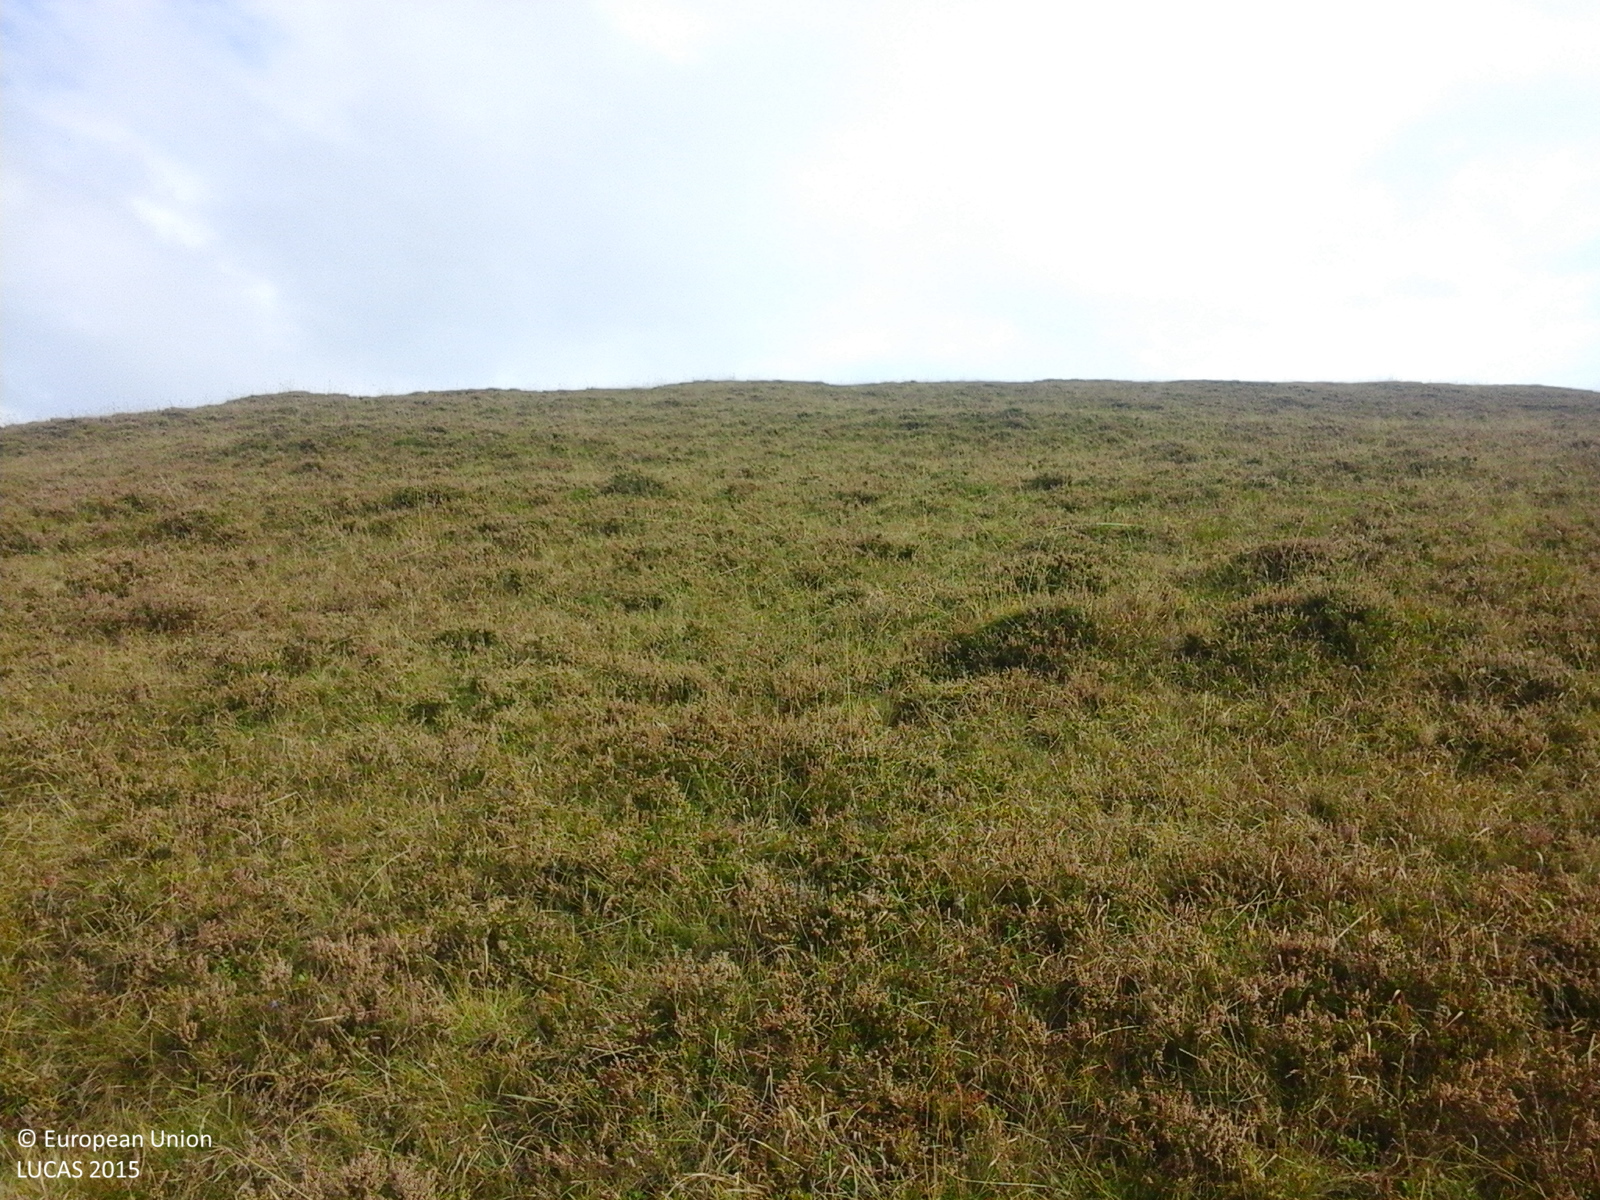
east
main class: Grassland
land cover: Grassland without tree/shrub cover
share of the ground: > 75 %
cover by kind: herbaceous plants 100 %
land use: Agriculture (excluding fallow land and kitchen gardens)
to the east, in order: Grassland without tree/shrub cover
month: October
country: RO
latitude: 46.6922
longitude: 23.2322
